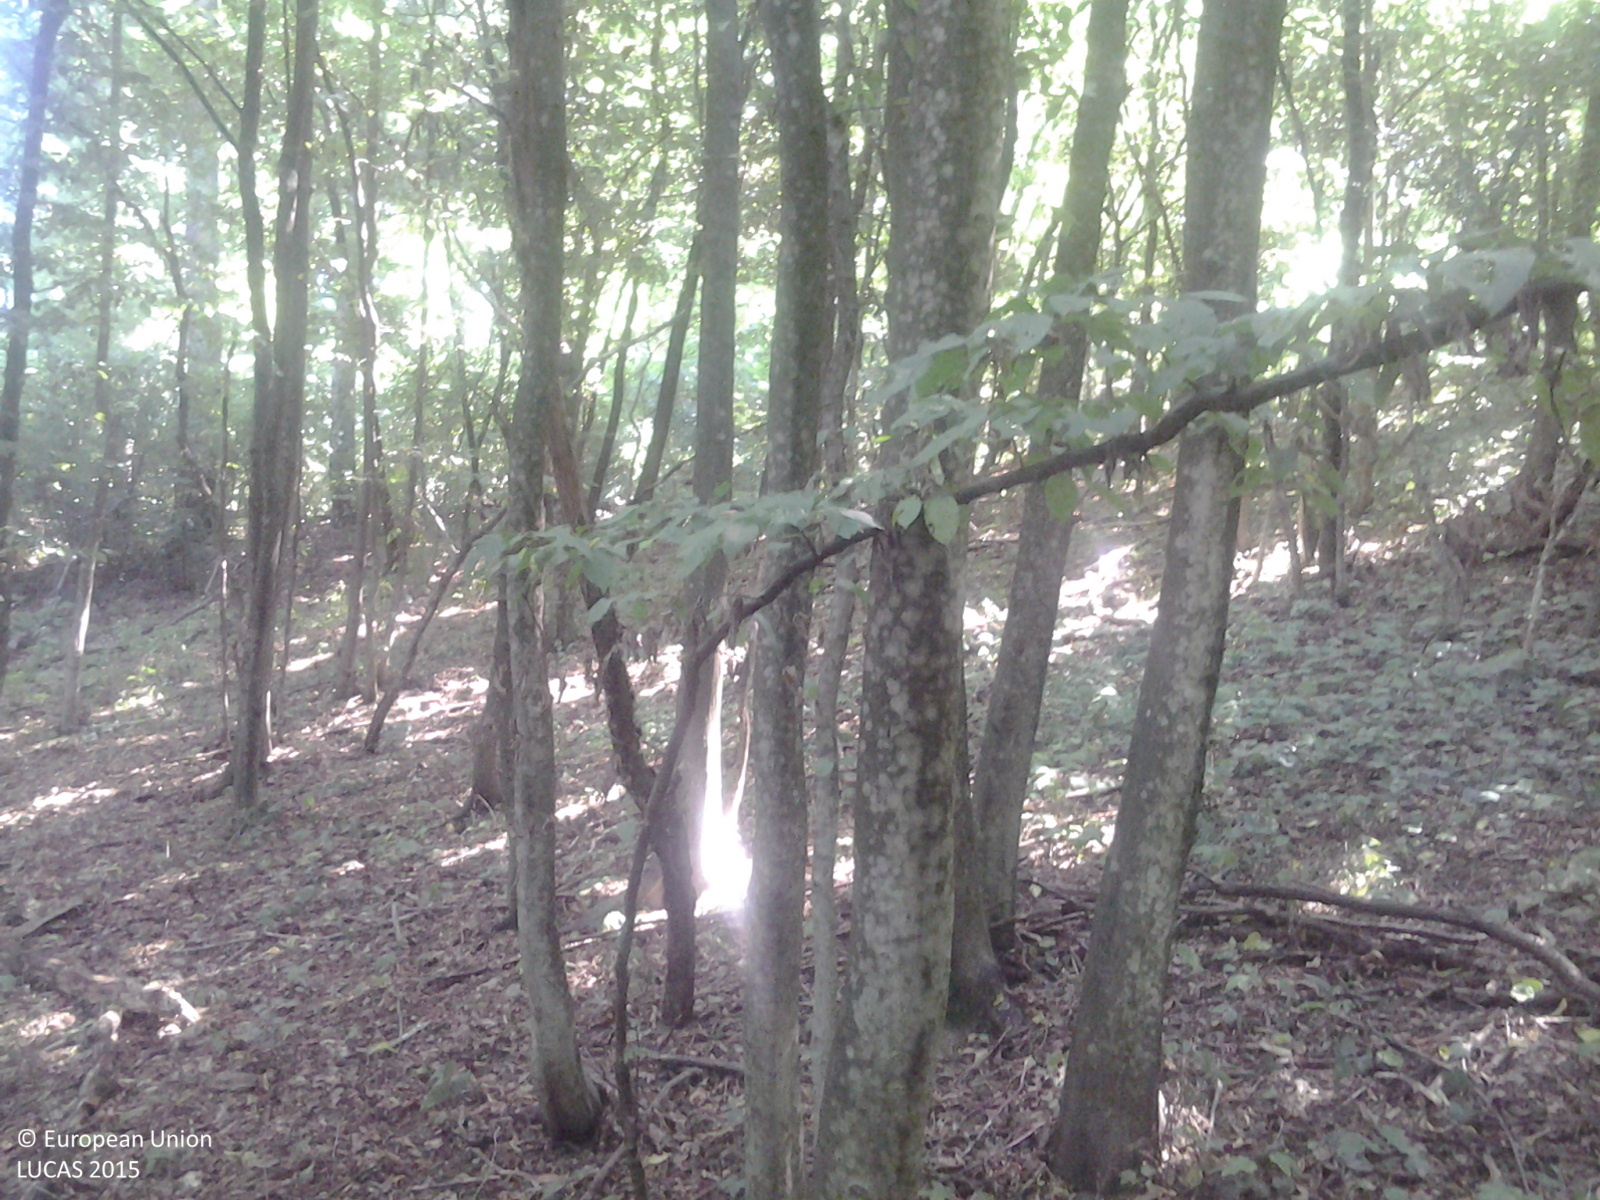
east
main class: Woodland
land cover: Broadleaved woodland
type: beech forest
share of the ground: > 75 %
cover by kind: broadleaved forest trees 100 %
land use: Forestry
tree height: > 5 m
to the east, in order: Broadleaved woodland; Tracks; Broadleaved woodland; Grassland without tree/shrub cover
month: August
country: HU
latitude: 46.5679
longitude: 17.0877
